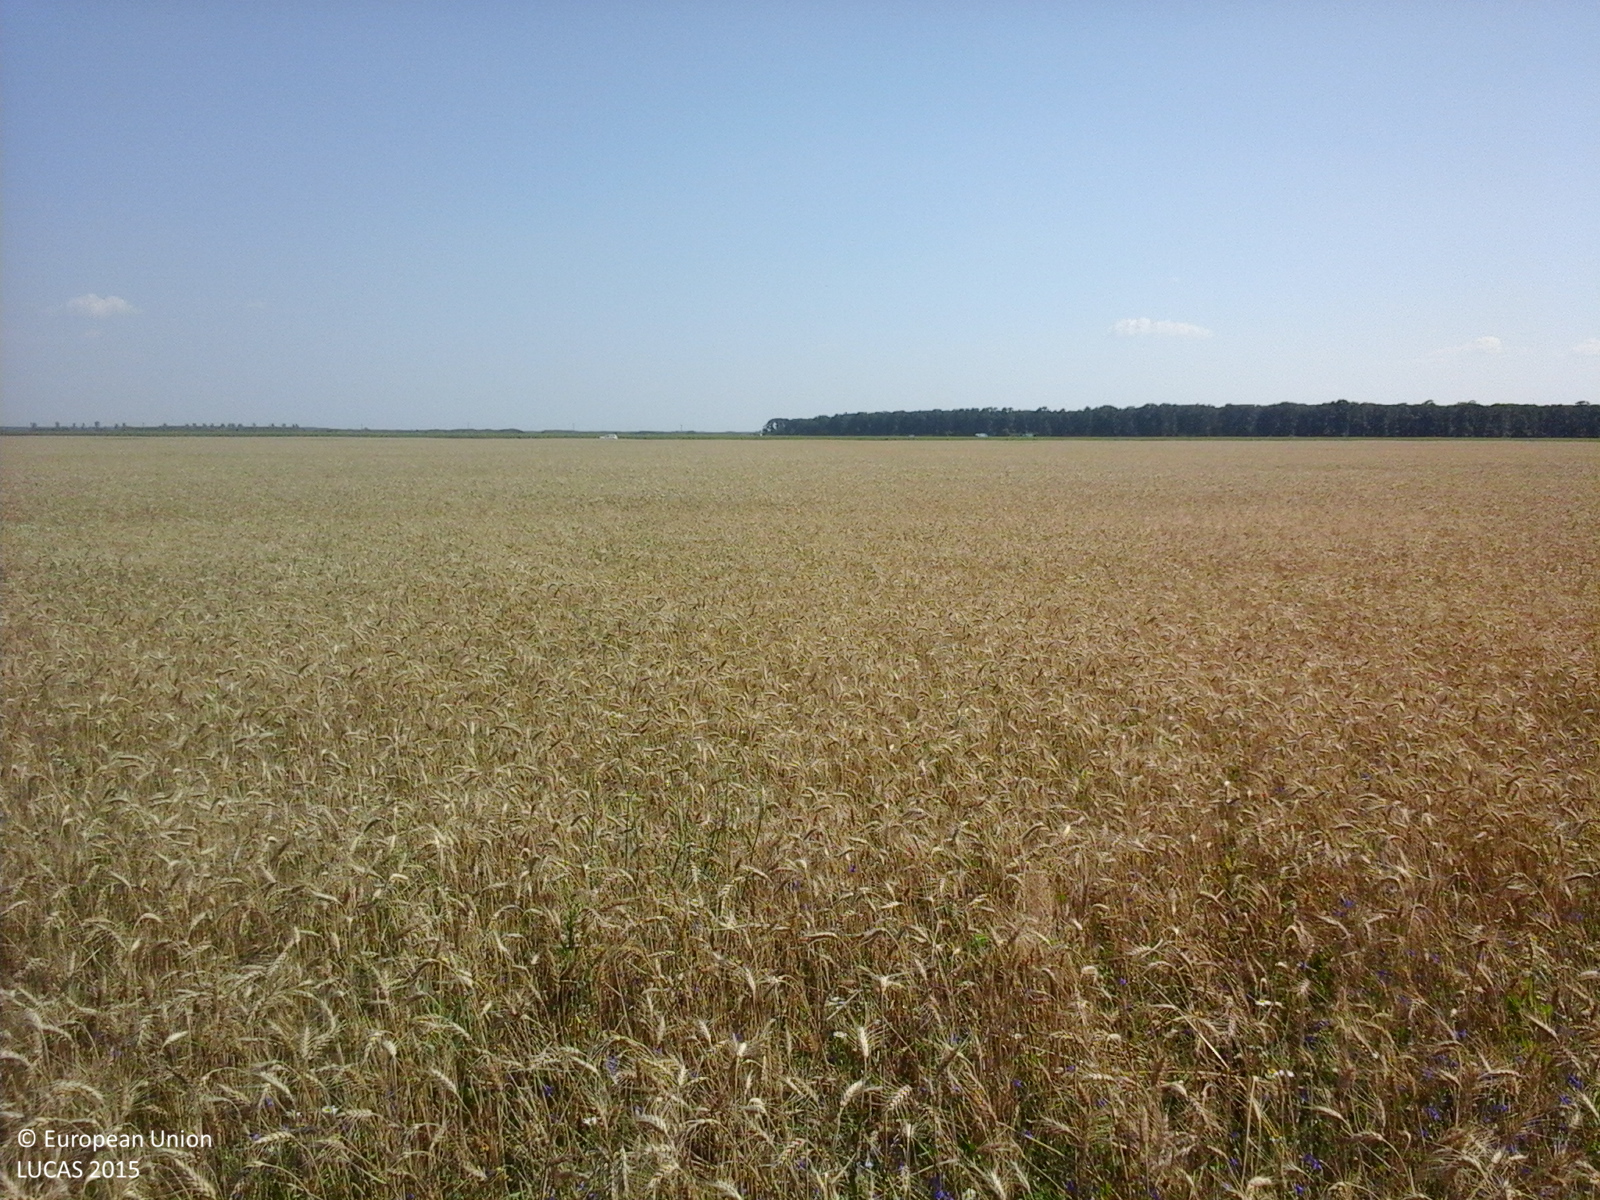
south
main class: Cropland
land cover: Common wheat
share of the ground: > 75 %
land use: Agriculture (excluding fallow land and kitchen gardens)
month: July
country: RO
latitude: 44.2118
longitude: 24.5754
